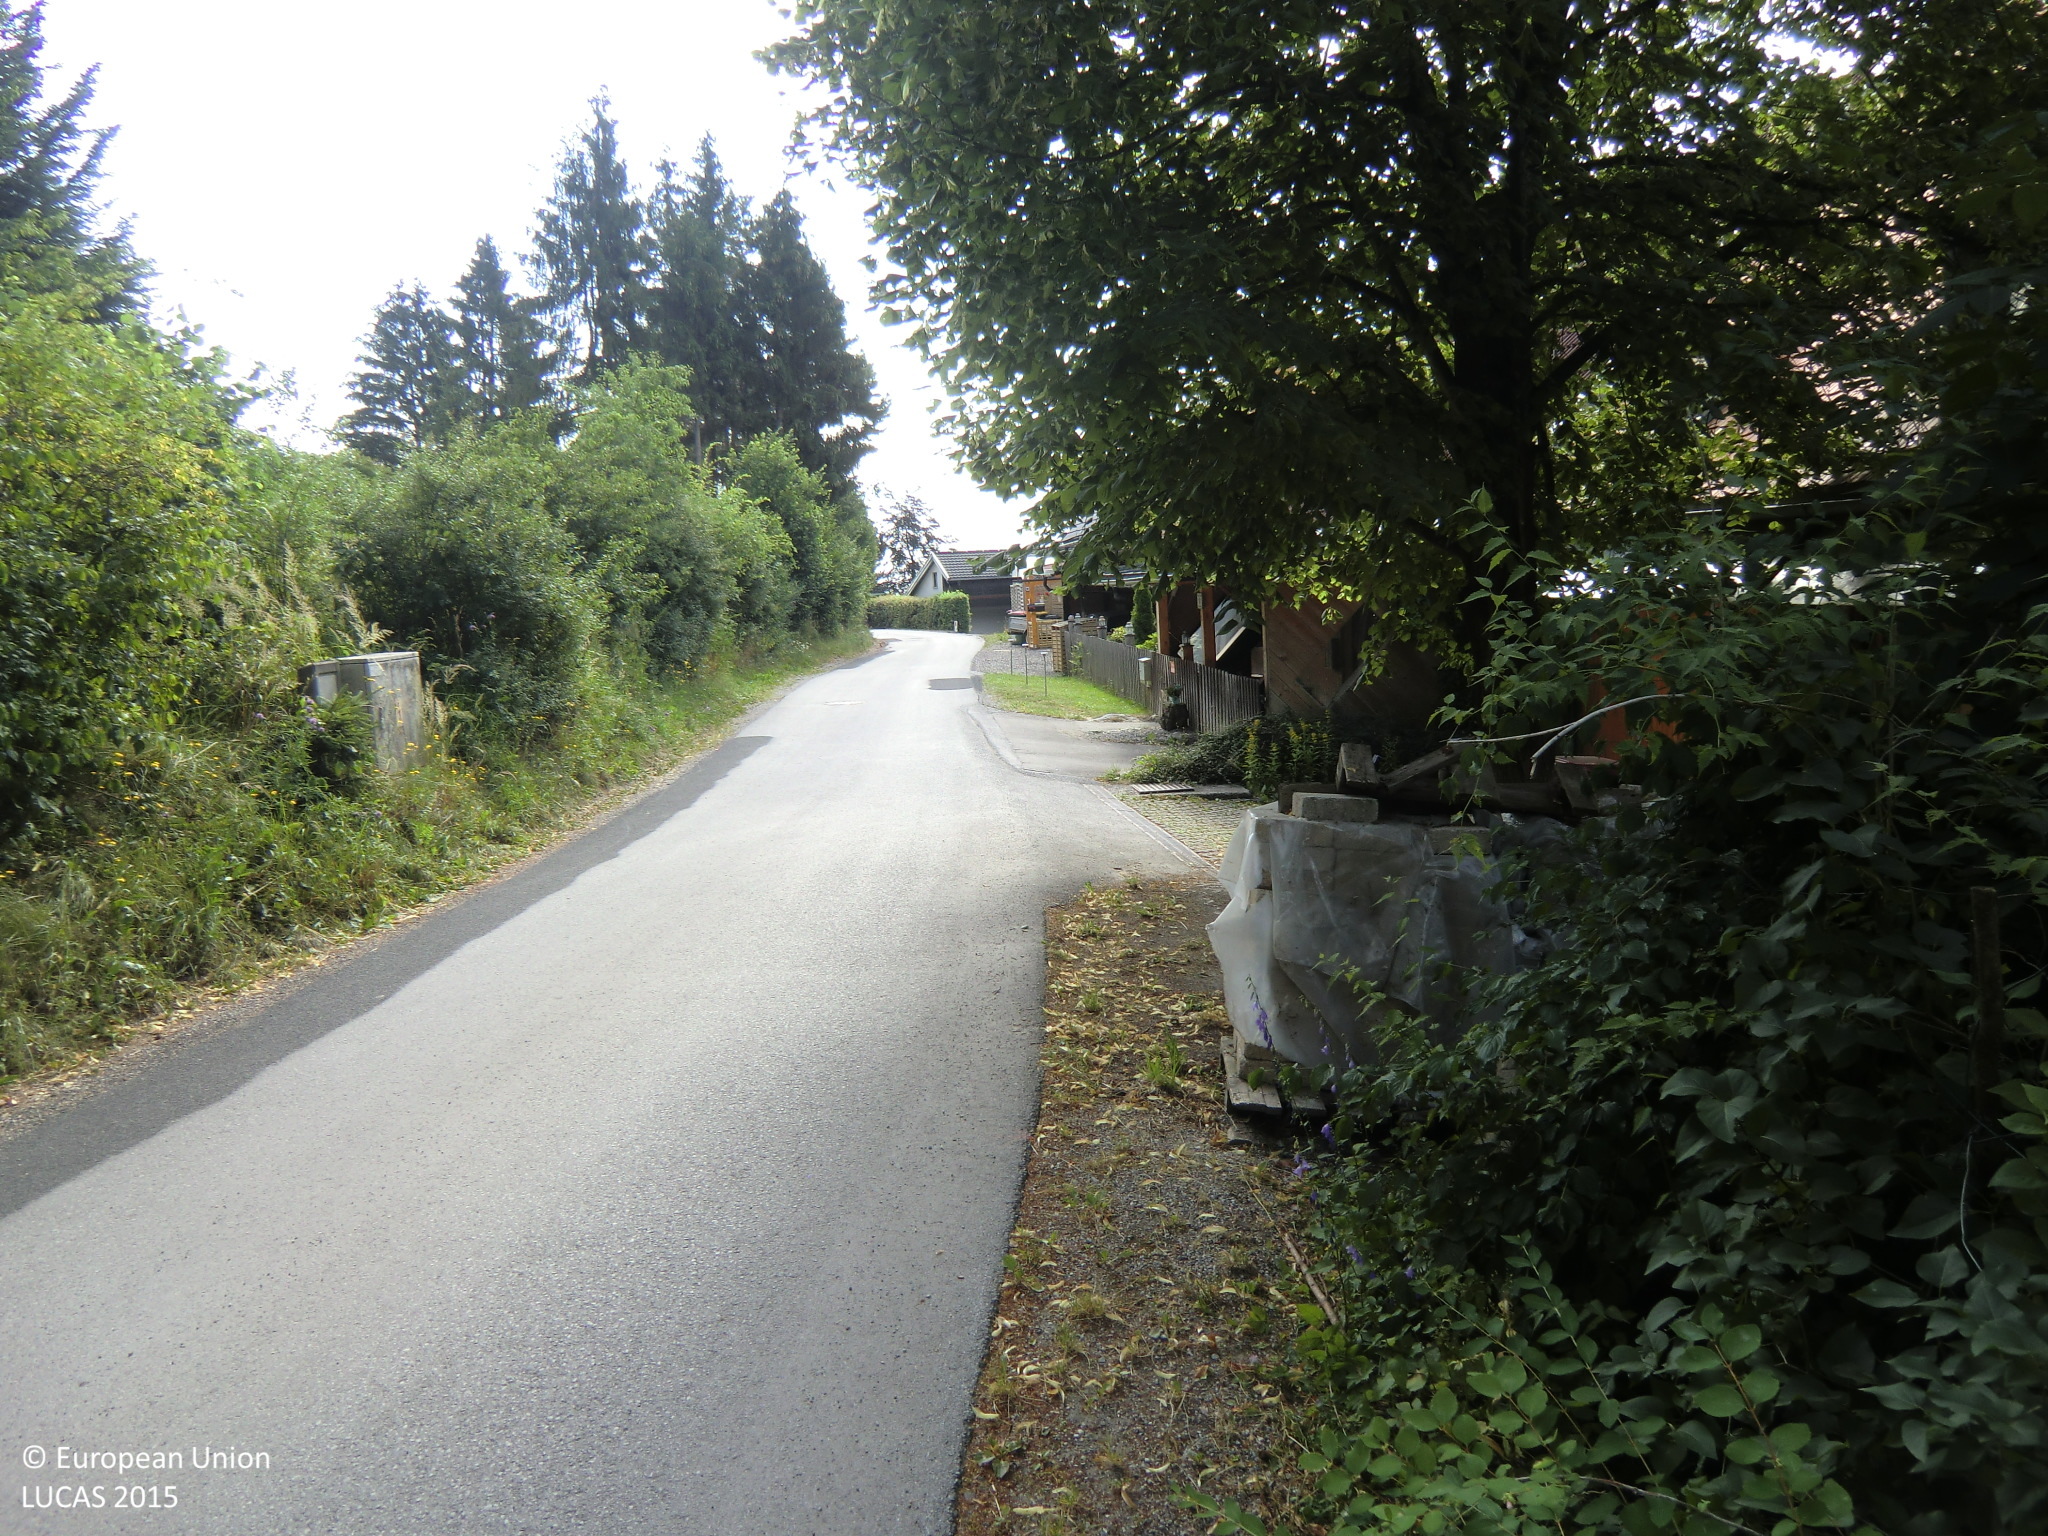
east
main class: Woodland
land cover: Other mixed woodland
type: hemiboreal forest and nemoral coniferous forest and mixed broadleaved-coniferous forest
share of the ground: > 75 %
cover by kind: coniferous forest trees 45 %, broadleaved forest trees 45 %, unconsolidated bare surface 10 %
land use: Forestry
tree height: > 5 m
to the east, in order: Other mixed woodland; Artificial constructions in urban areas
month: July
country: AT
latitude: 47.1509
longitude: 15.4468
